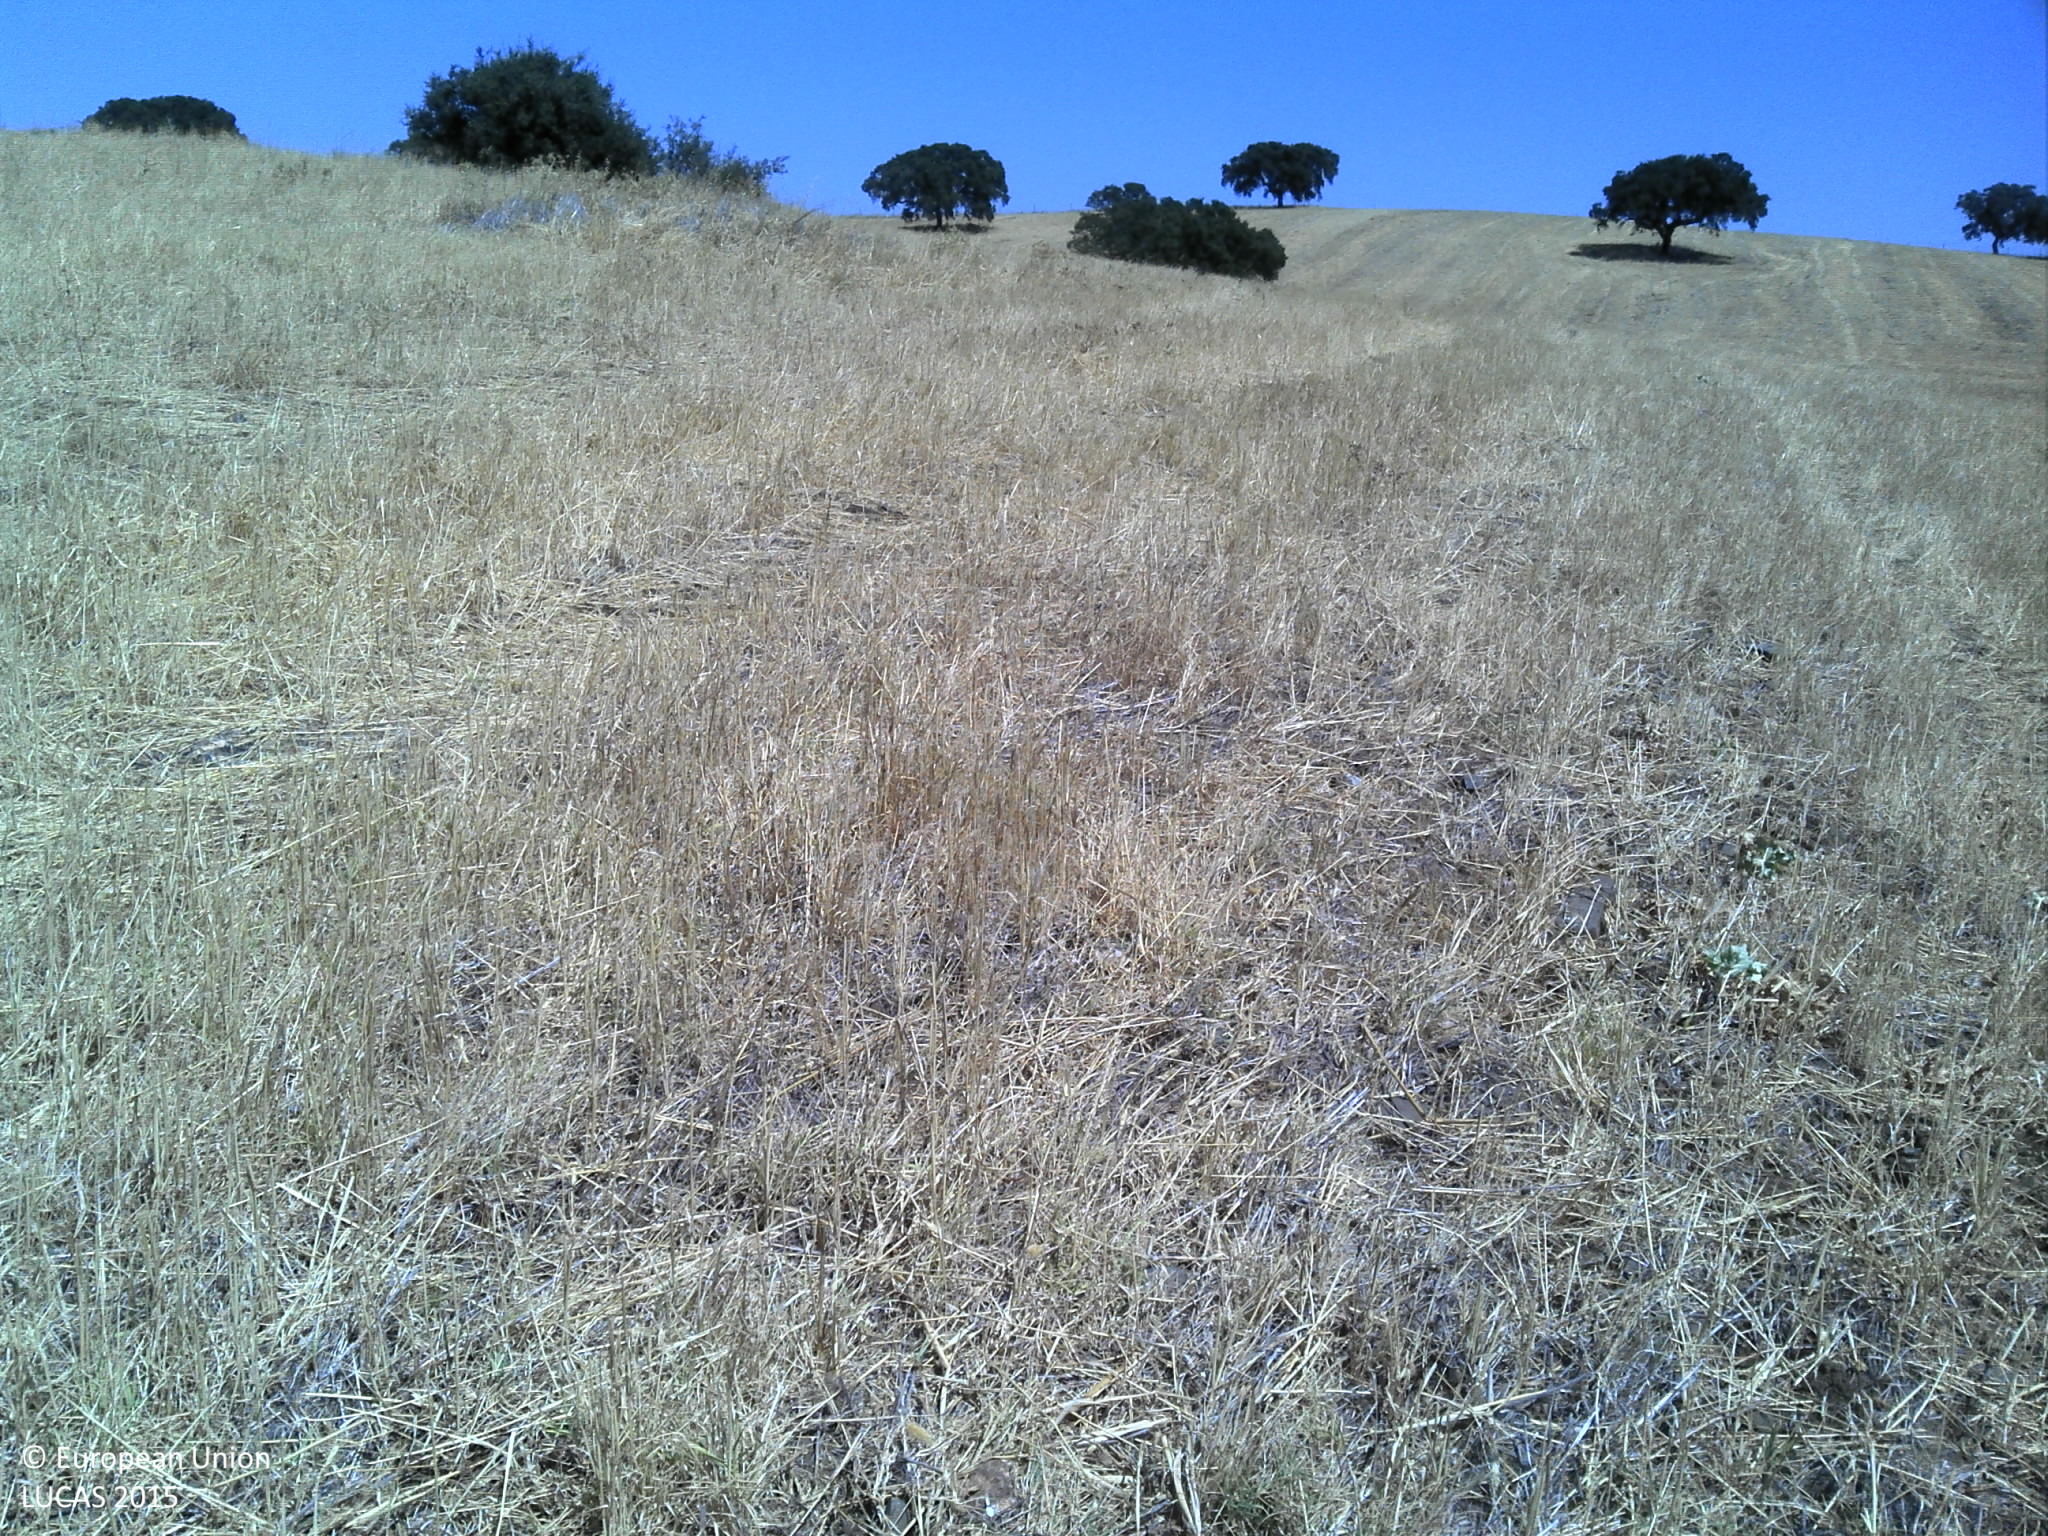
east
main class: Cropland
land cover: Common wheat
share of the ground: > 75 %
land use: Agriculture (excluding fallow land and kitchen gardens)
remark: Harvested field
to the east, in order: Common wheat; Single bushes/trees; Common wheat
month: August
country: PT
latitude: 38.0480
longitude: -7.7221
